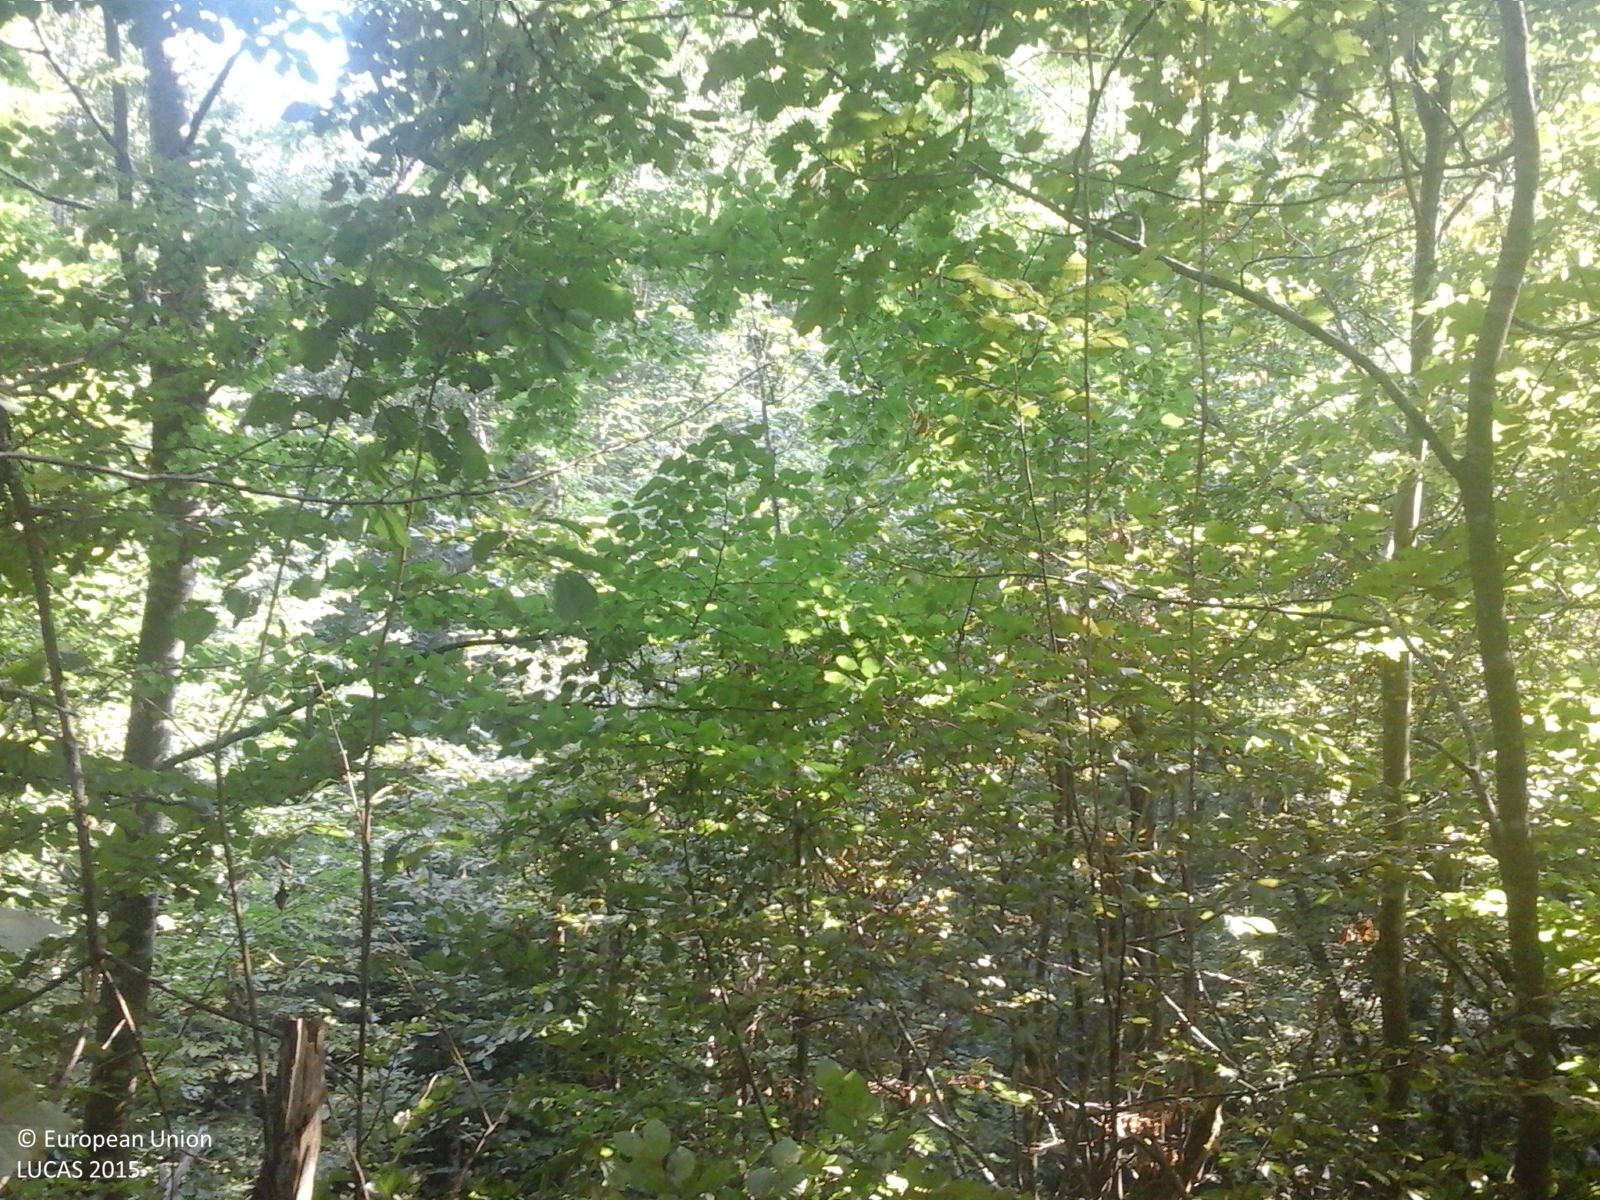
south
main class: Woodland
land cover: Broadleaved woodland
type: beech forest
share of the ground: > 75 %
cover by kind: broadleaved forest trees 100 %
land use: Forestry
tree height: > 5 m
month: August
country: RO
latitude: 46.4340
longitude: 22.3475
